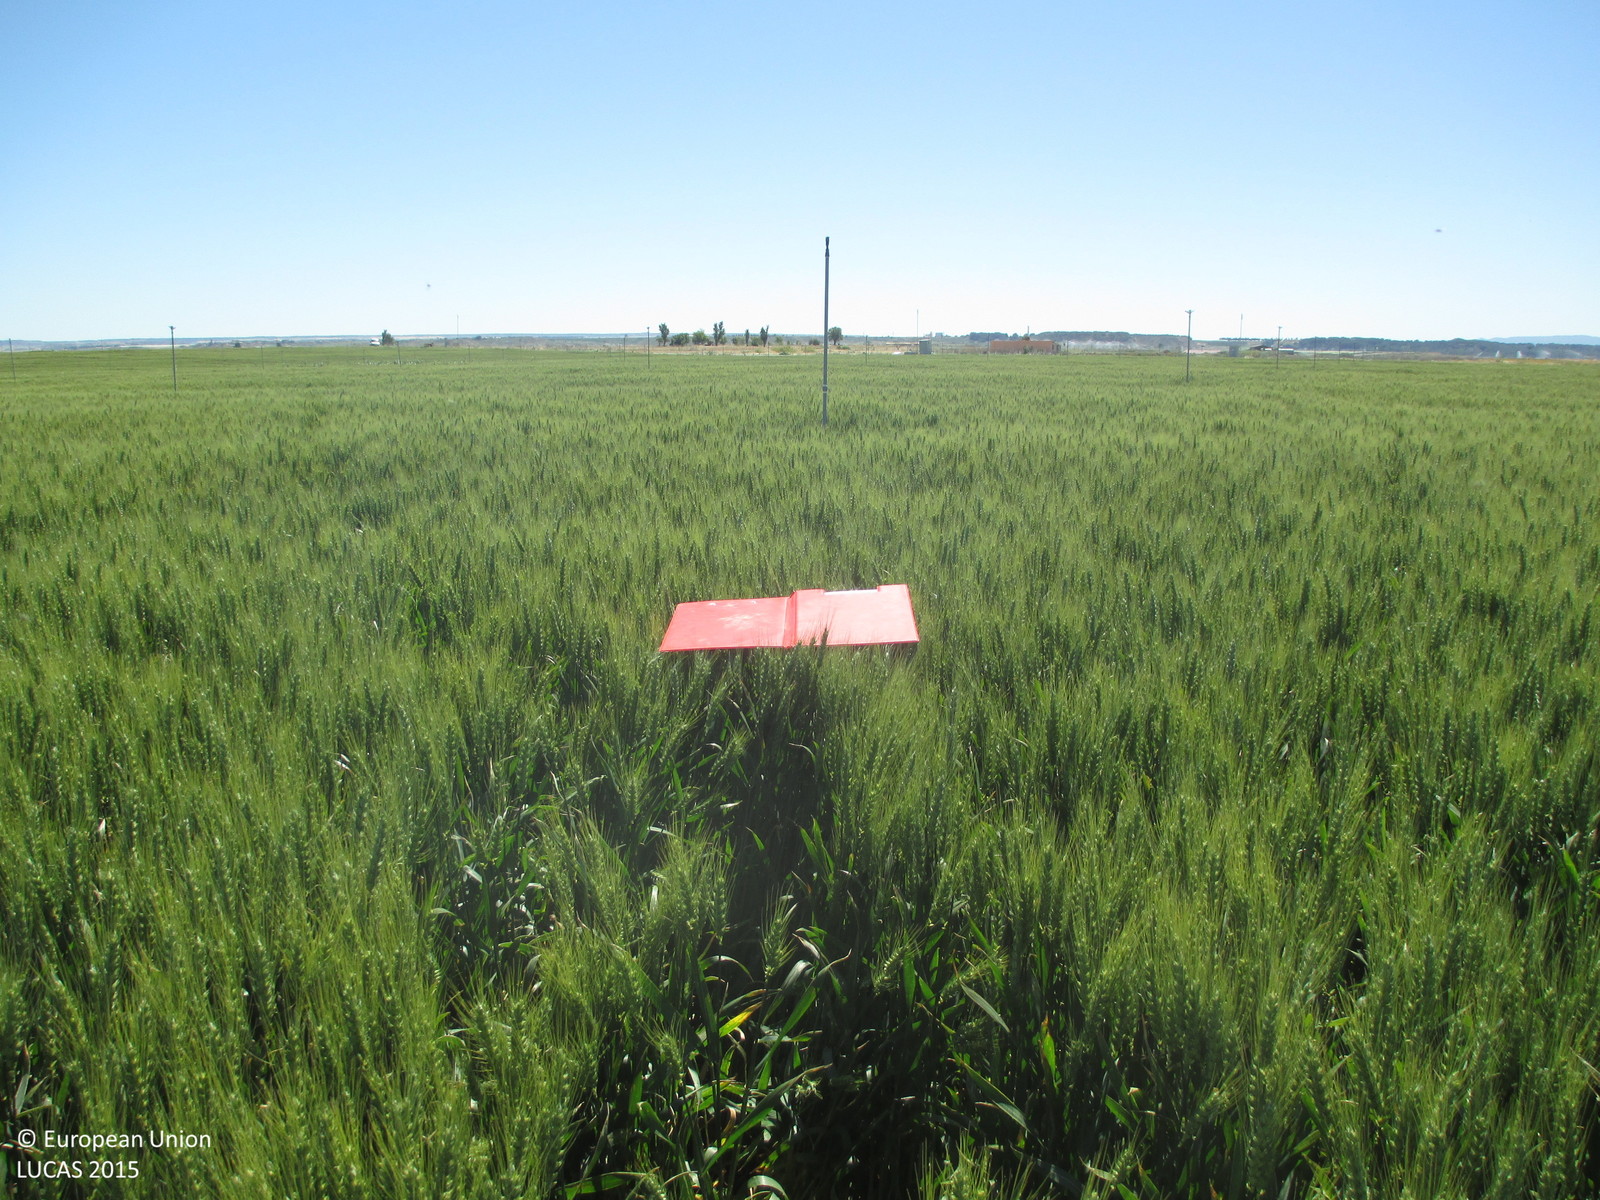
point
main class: Cropland
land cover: Durum wheat
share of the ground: > 75 %
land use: Agriculture (excluding fallow land and kitchen gardens)
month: May
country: ES
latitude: 41.8422
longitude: -0.2435
